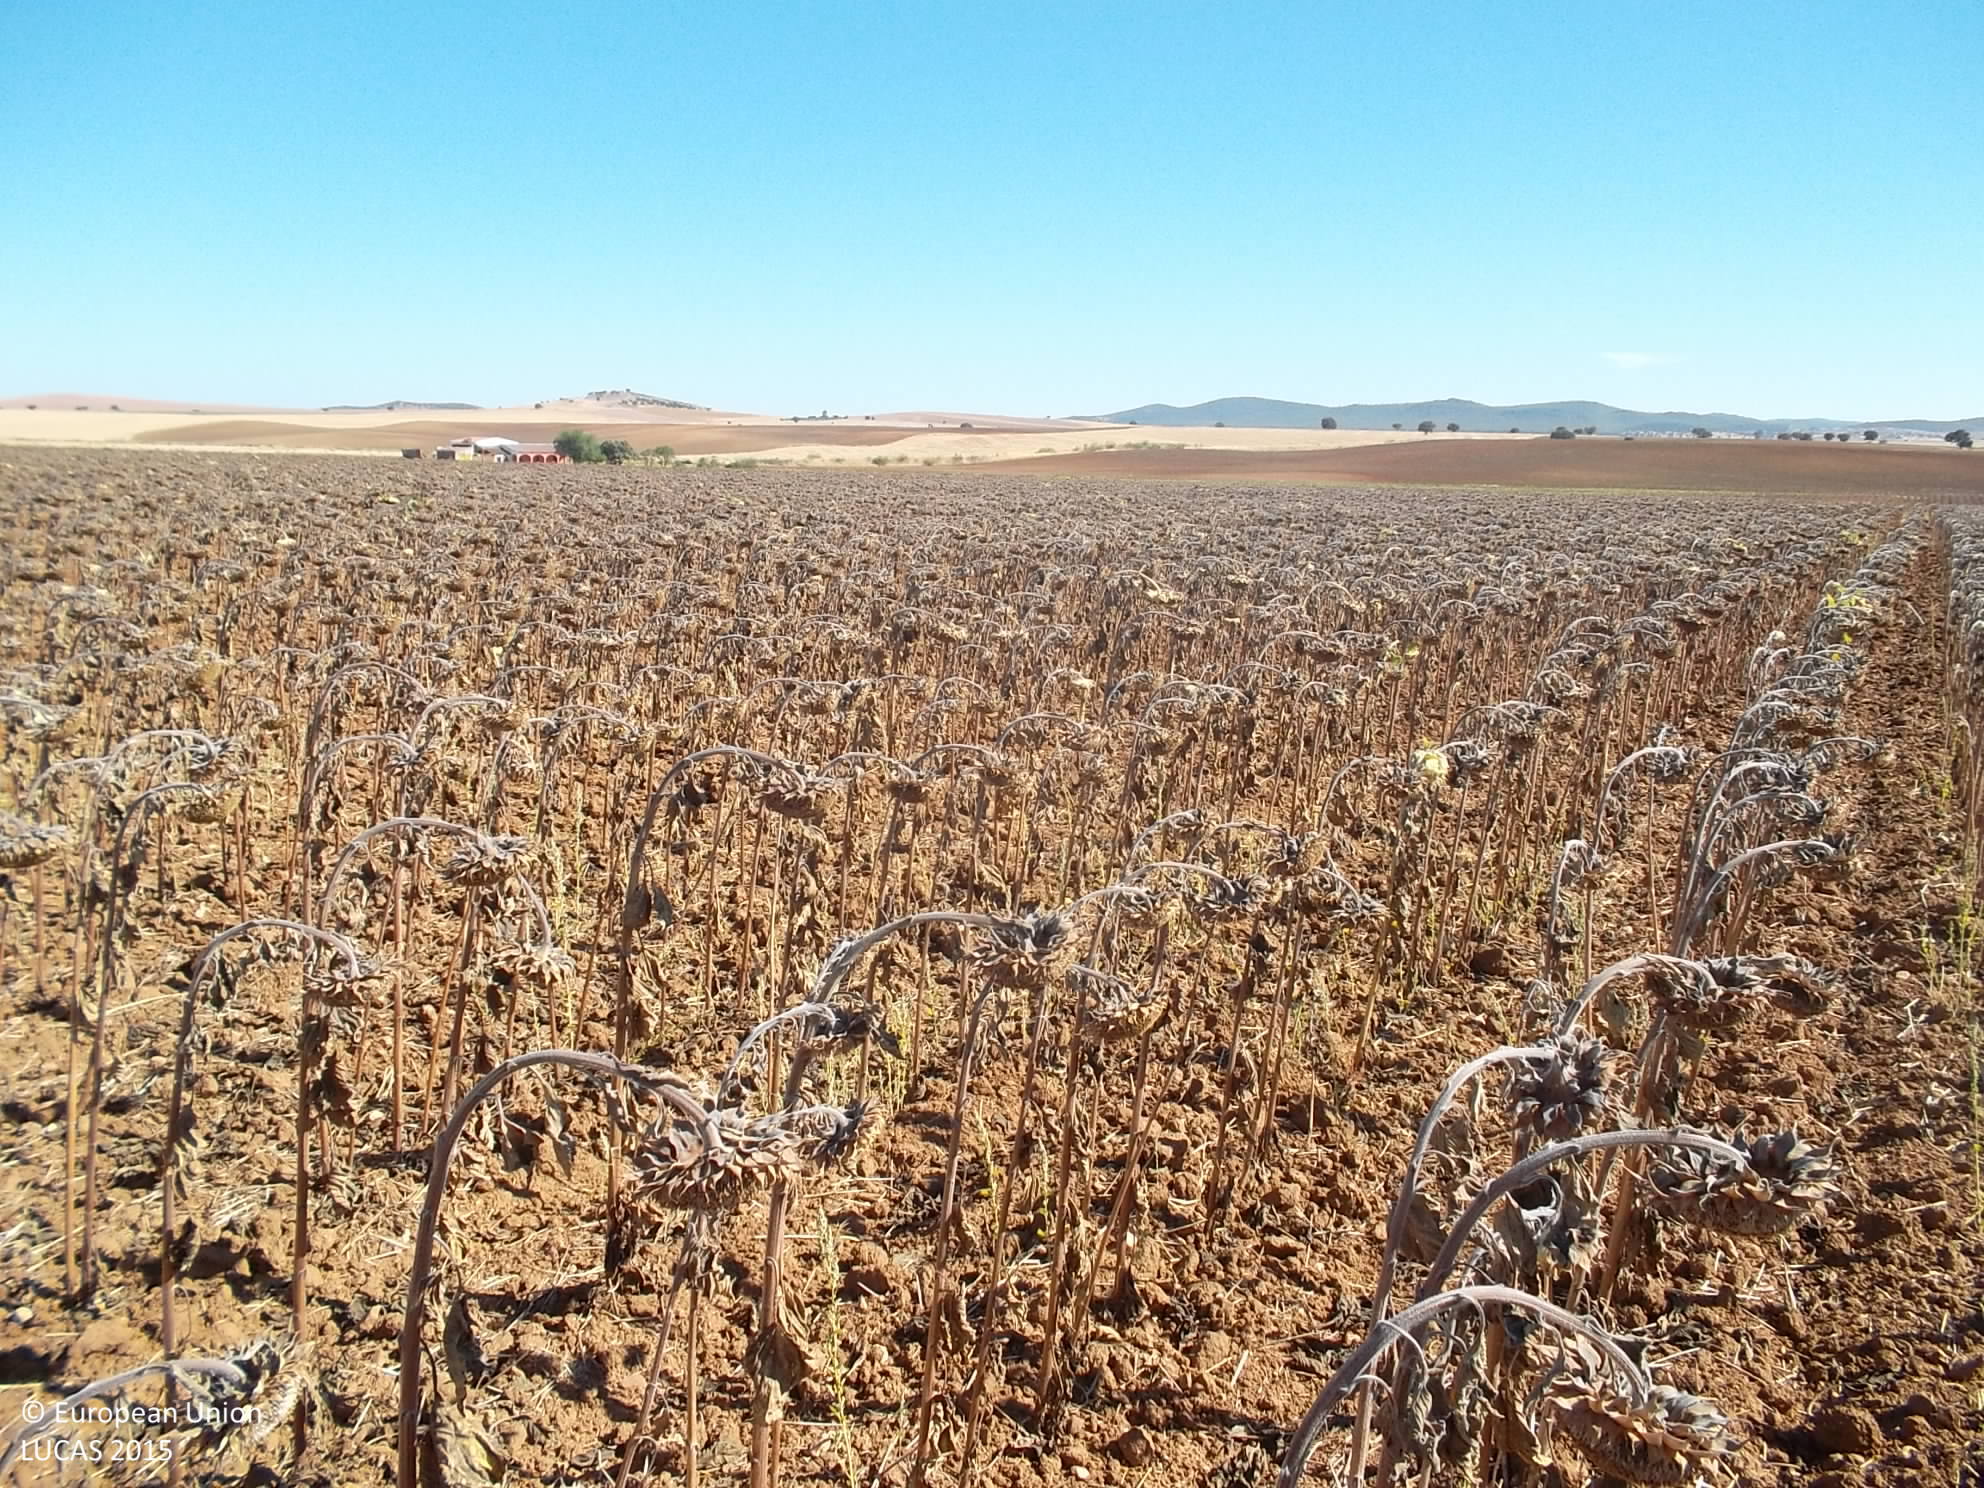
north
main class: Cropland
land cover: Sunflower
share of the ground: > 75 %
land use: Agriculture (excluding fallow land and kitchen gardens)
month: July
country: ES
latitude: 38.4033
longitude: -5.7138
